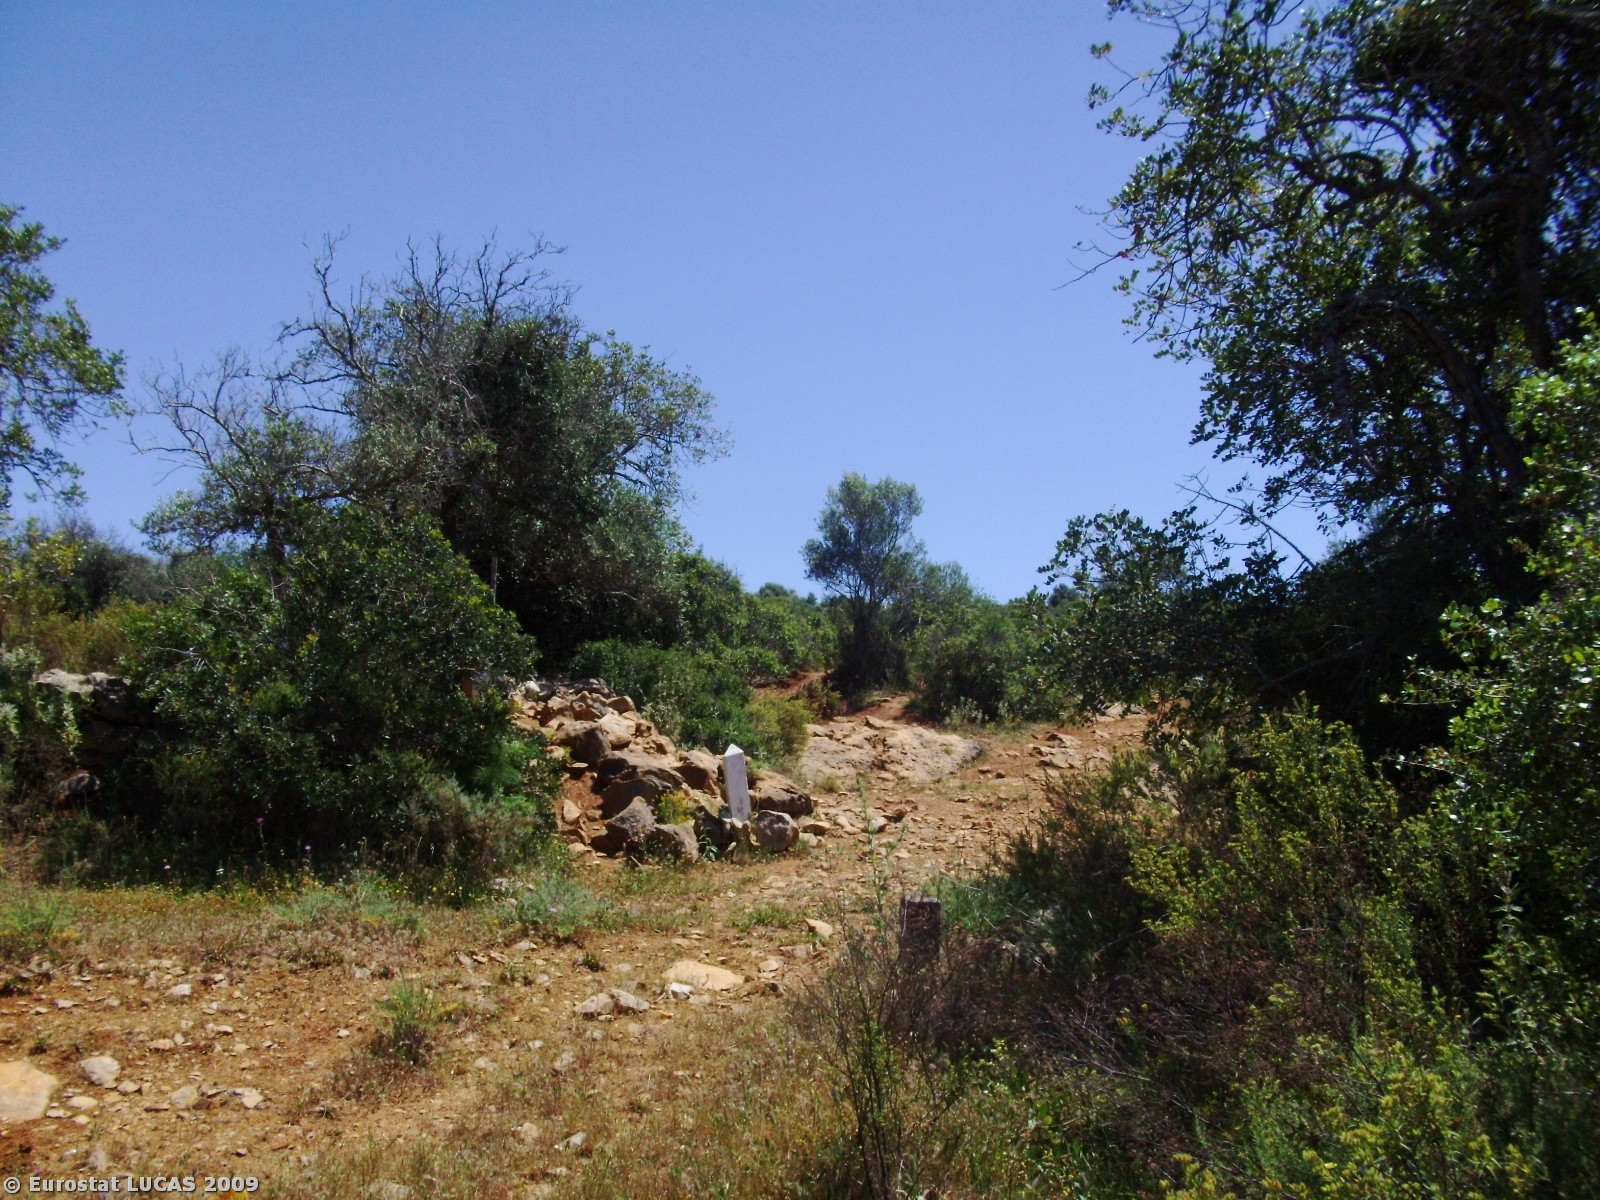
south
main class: Grassland
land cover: Grassland with sparse tree/shrub cover
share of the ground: > 75 %
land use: Fallow land
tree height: > 5 m
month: May
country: PT
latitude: 37.1432
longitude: -8.3839
